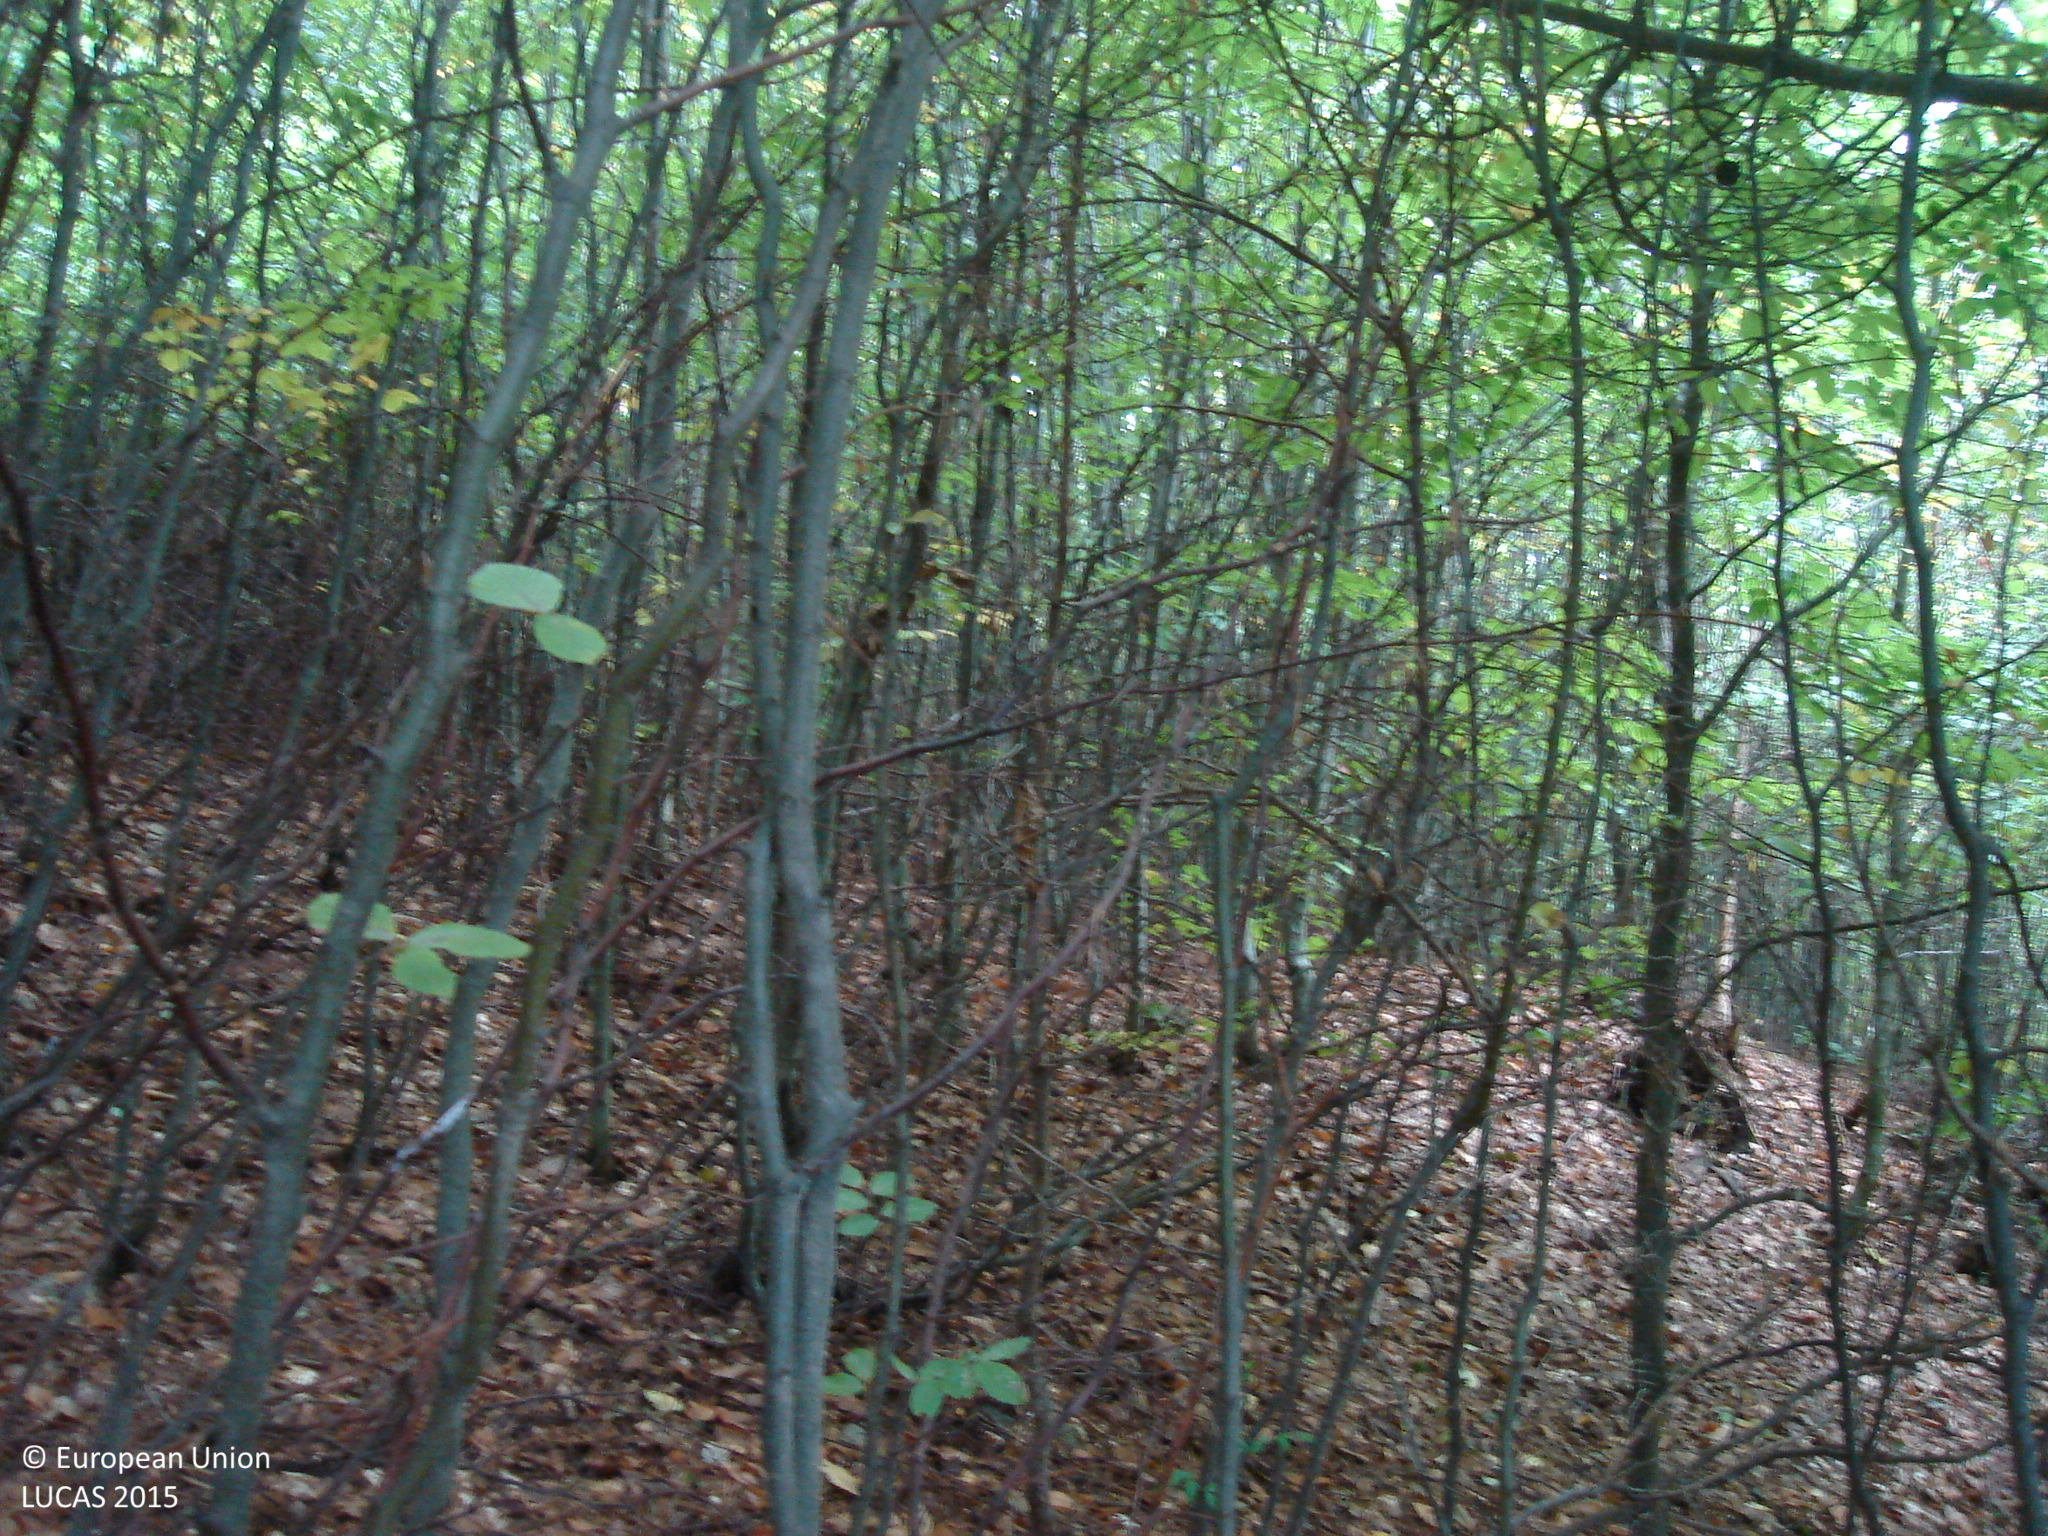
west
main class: Woodland
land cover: Spruce dominated mixed woodland
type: hemiboreal forest and nemoral coniferous forest and mixed broadleaved-coniferous forest
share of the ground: > 75 %
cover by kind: coniferous forest trees 50 %, broadleaved forest trees 40 %, unconsolidated bare surface 10 %
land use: Forestry
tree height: > 5 m
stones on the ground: < 10 %
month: October
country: BG
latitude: 42.9991
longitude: 23.4215
